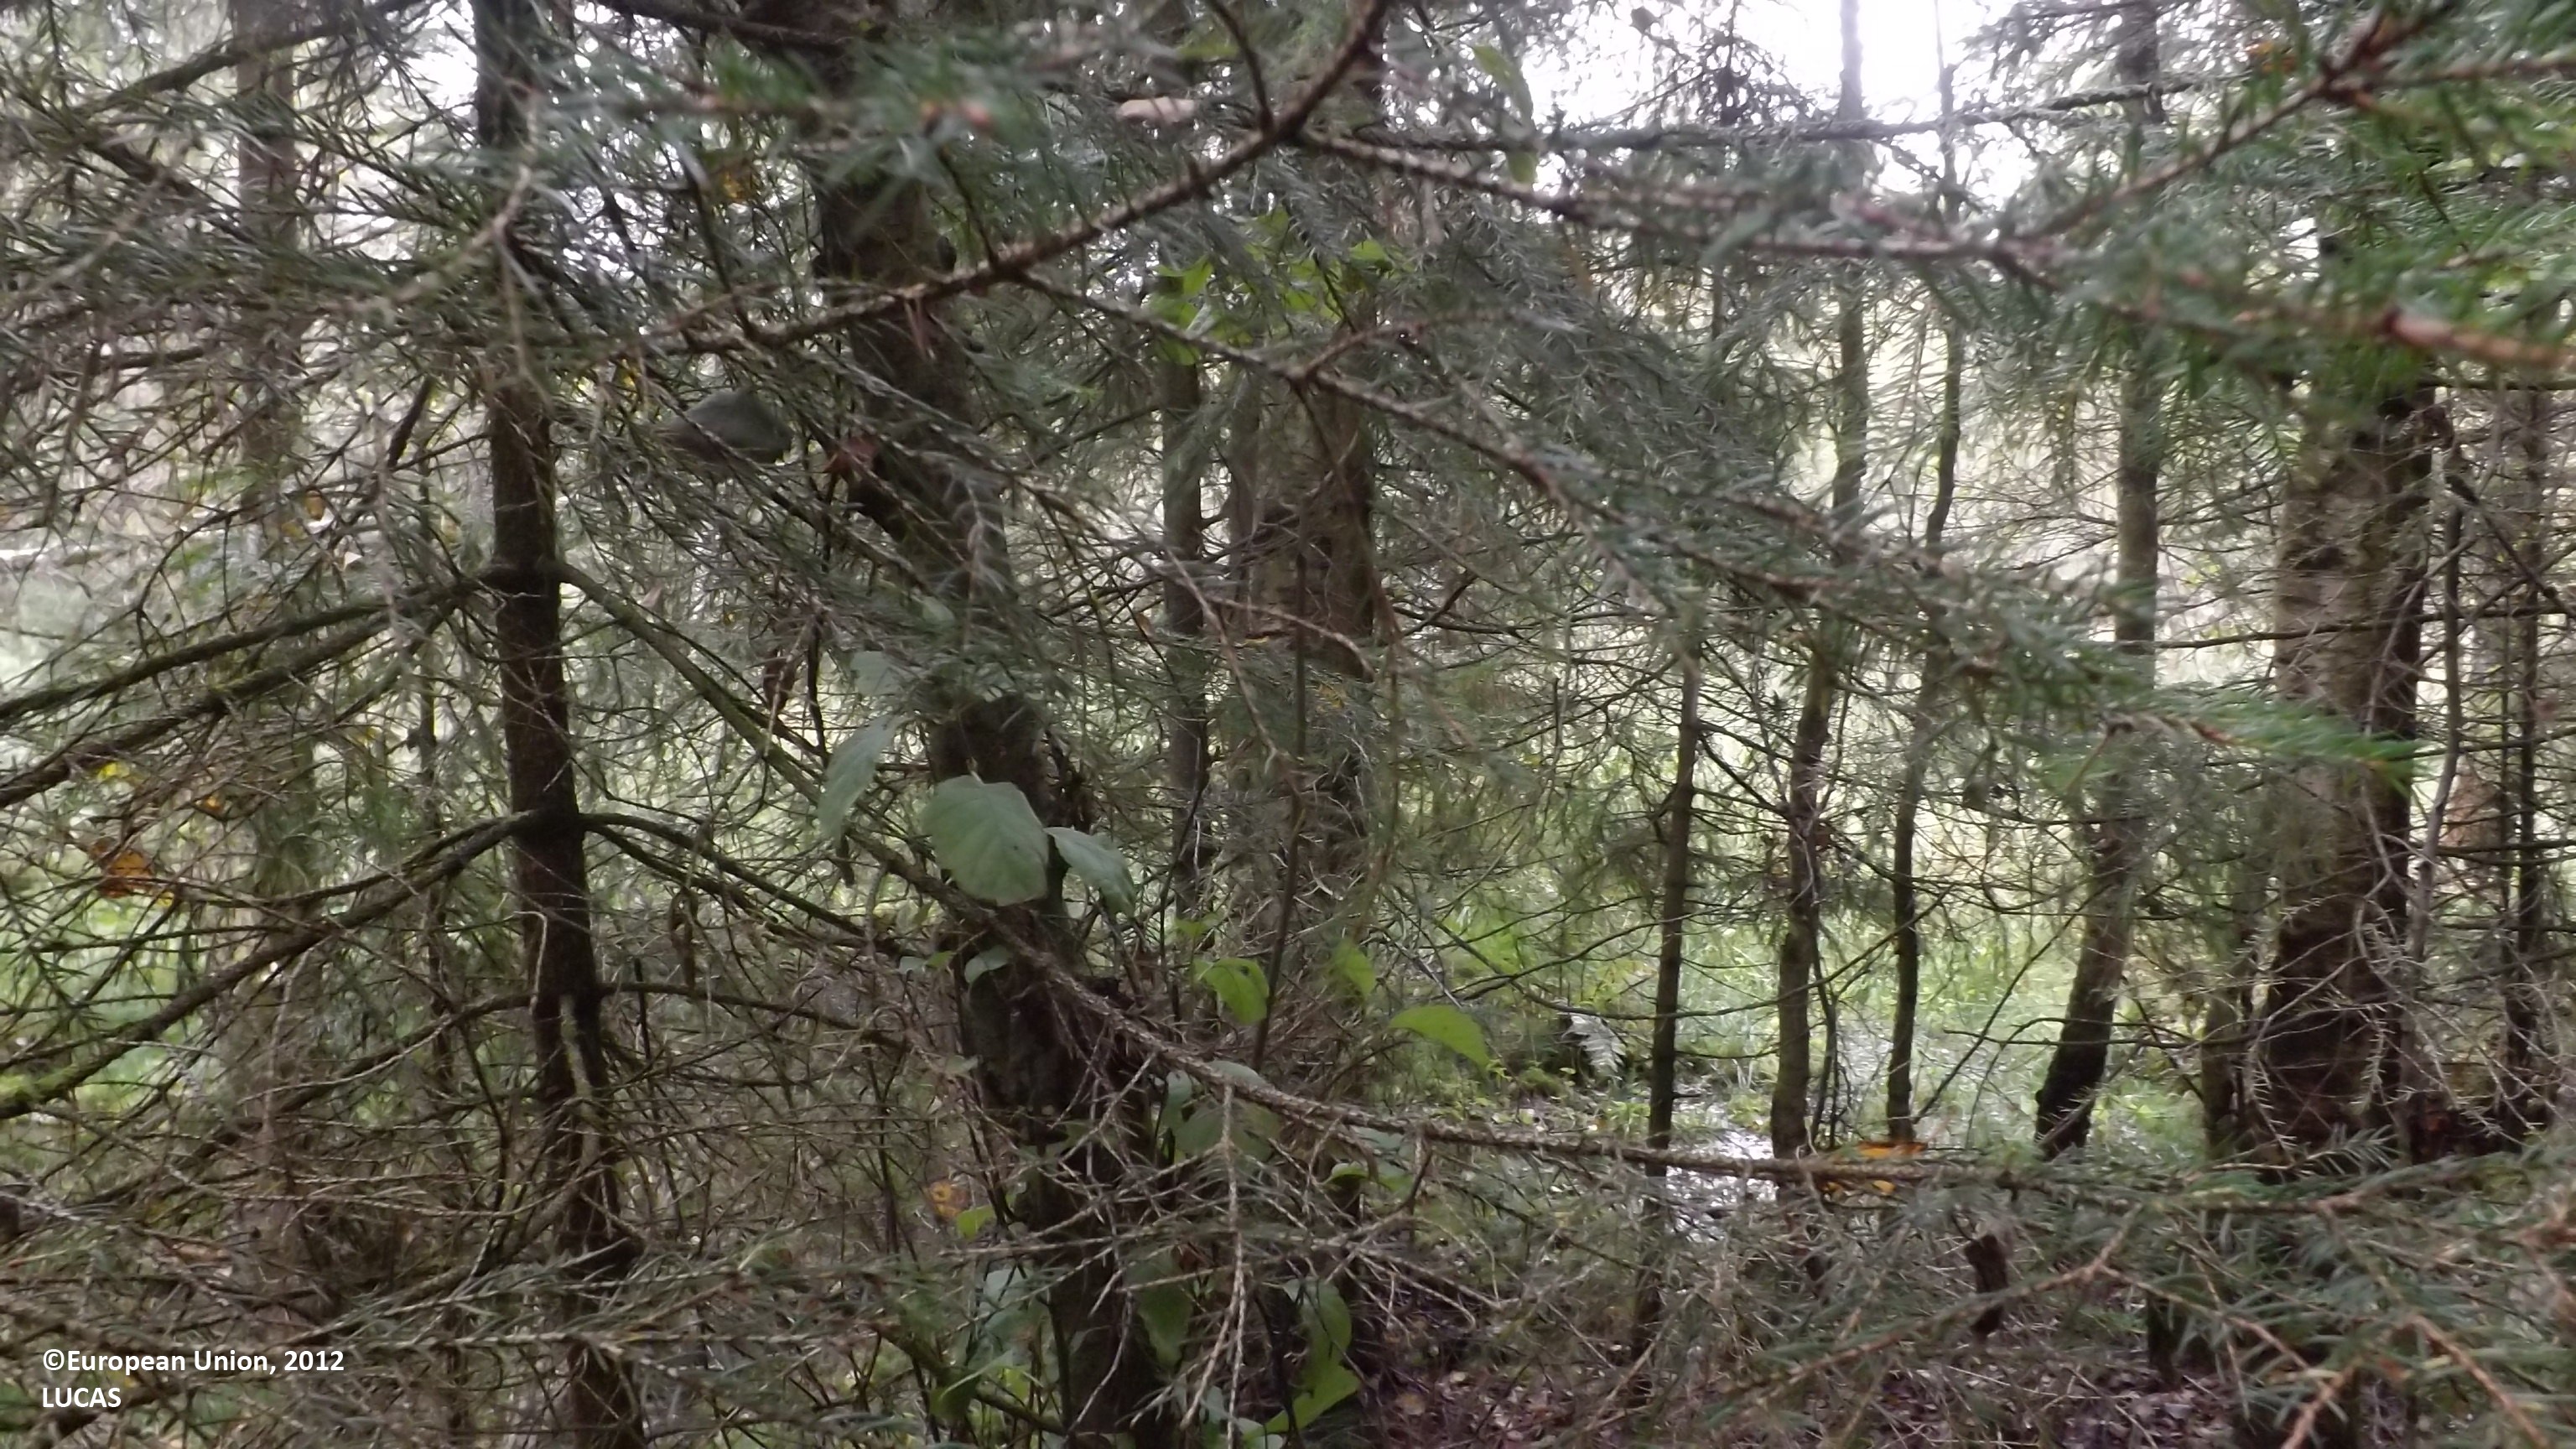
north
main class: Woodland
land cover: Spruce dominated mixed woodland
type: boreal forest
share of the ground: > 75 %
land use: Forestry
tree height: > 5 m
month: August
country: FI
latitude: 63.8437
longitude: 23.4156
